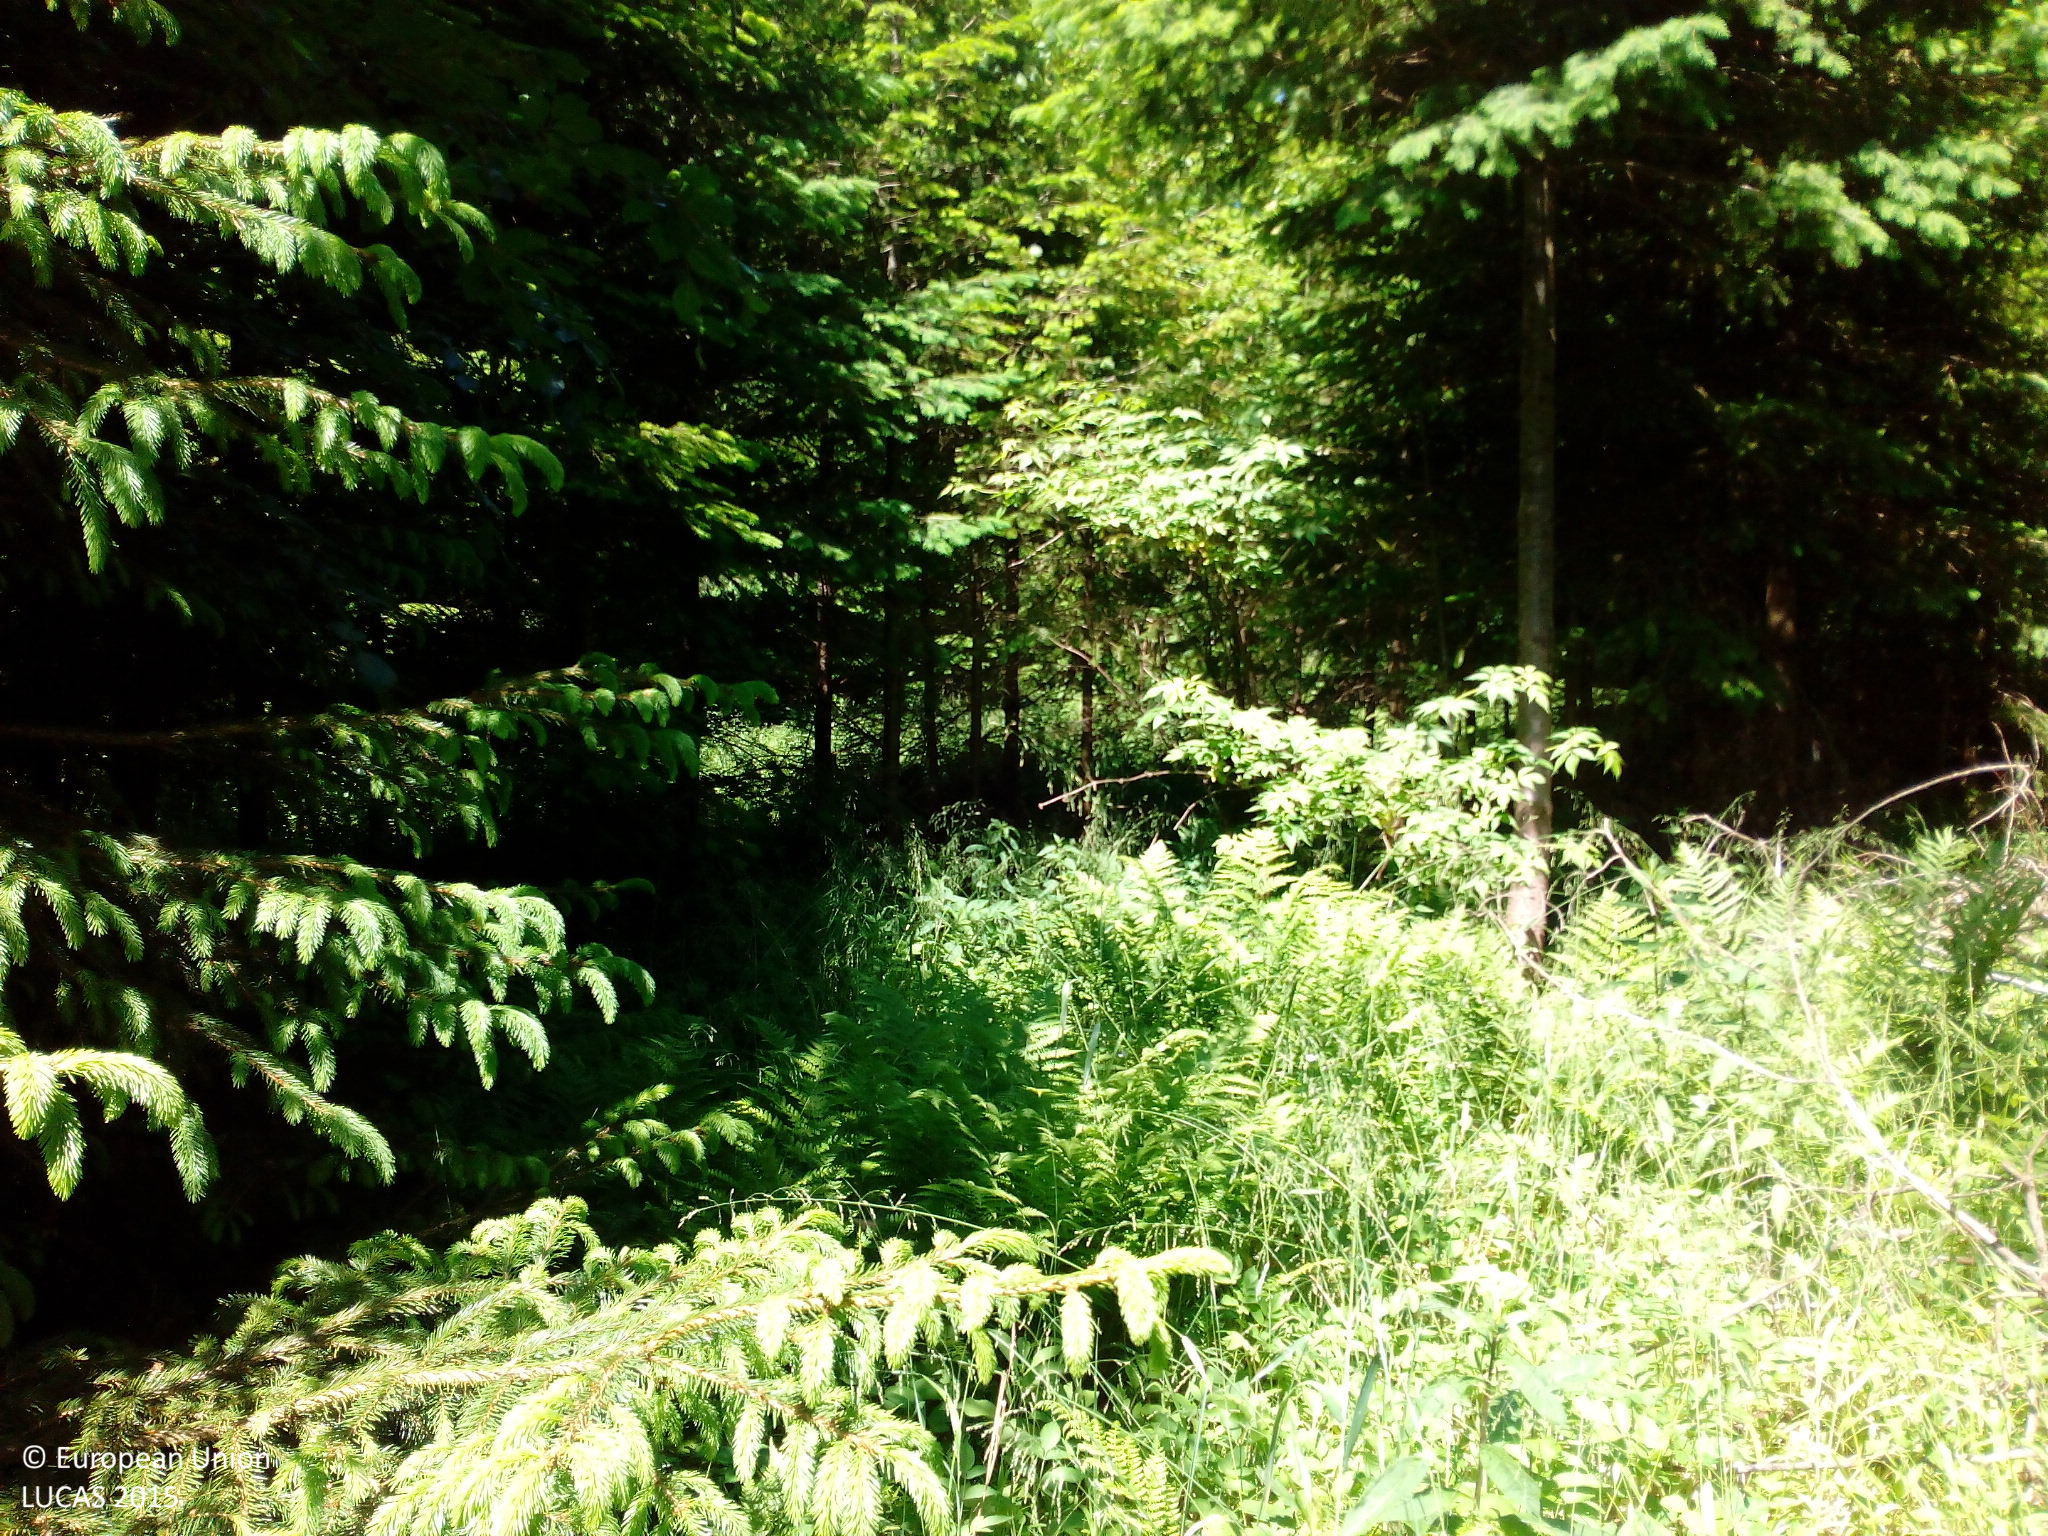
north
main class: Woodland
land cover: Spruce dominated mixed woodland
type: hemiboreal forest and nemoral coniferous forest and mixed broadleaved-coniferous forest
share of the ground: > 75 %
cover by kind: coniferous forest trees 50 %, broadleaved forest trees 40 %, shrubs 5 %, herbaceous plants 5 %
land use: Forestry
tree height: > 5 m
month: June
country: DE
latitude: 49.5532
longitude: 9.4058
